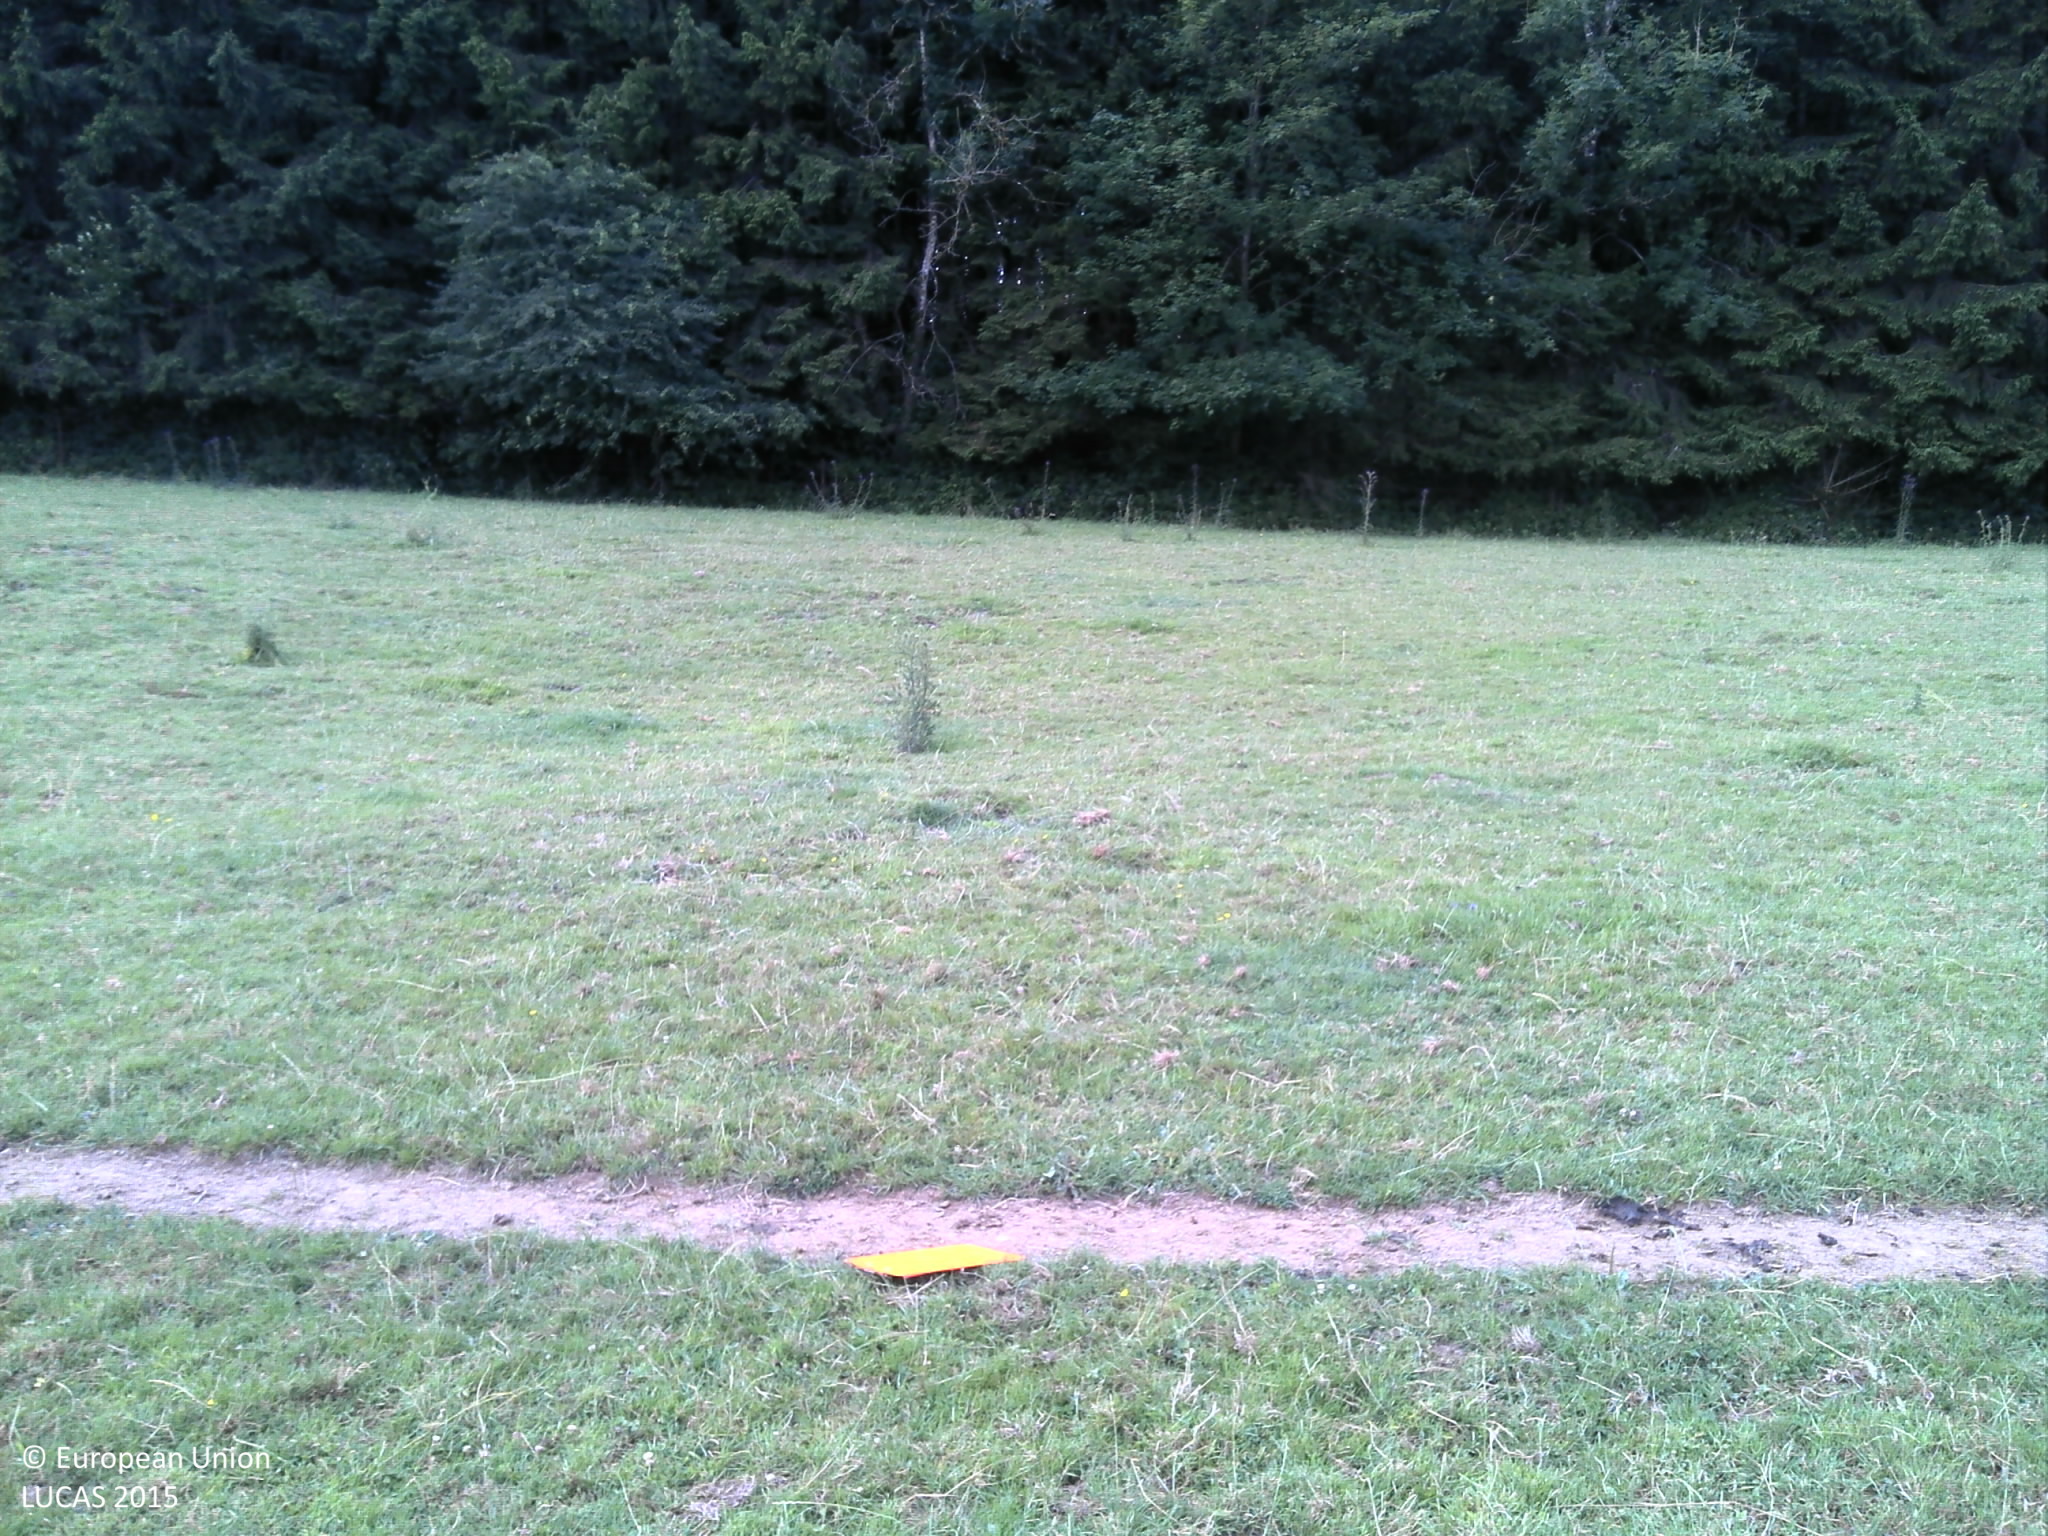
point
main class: Grassland
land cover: Grassland without tree/shrub cover
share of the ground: > 75 %
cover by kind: herbaceous plants 100 %
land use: Agriculture (excluding fallow land and kitchen gardens)
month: July
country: FR
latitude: 49.7073
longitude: 4.4632
